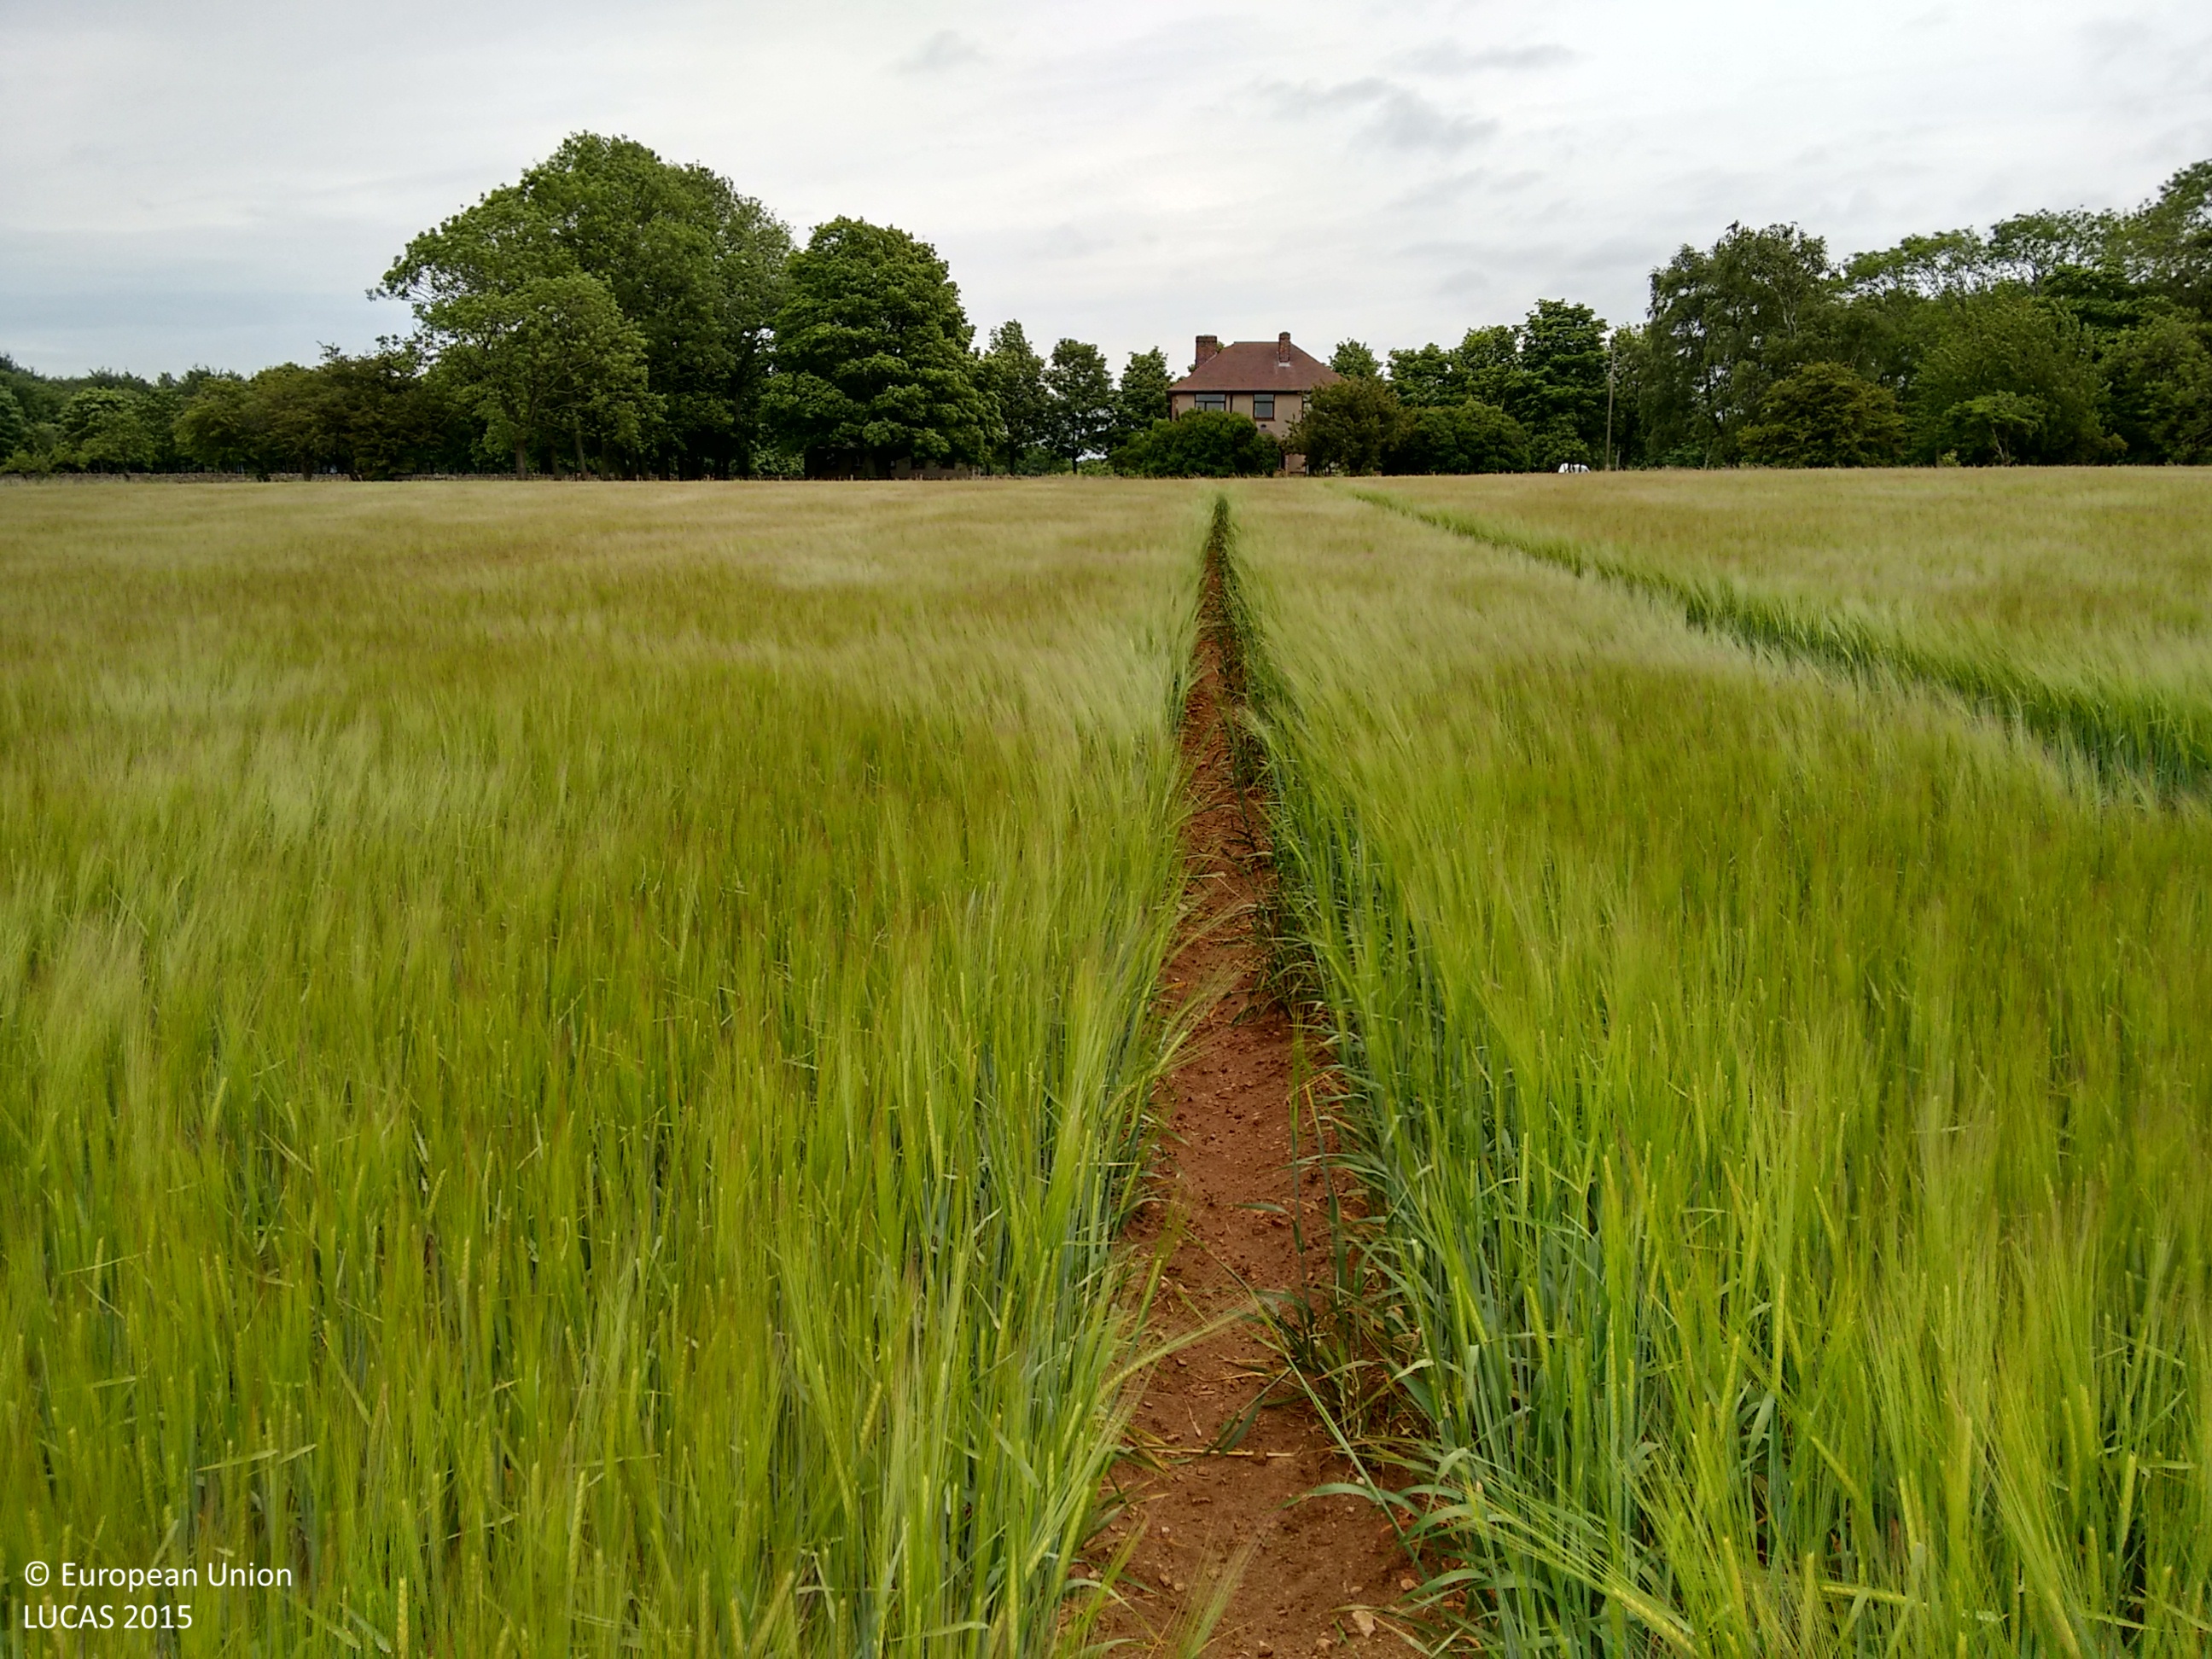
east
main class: Cropland
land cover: Barley
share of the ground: > 75 %
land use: Agriculture (excluding fallow land and kitchen gardens)
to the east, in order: Barley; Grass margins; Artificial constructions in urban areas; Grass margins; Broadleaved woodland; Grass margins; Fences; Grassland without tree/shrub cover
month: June
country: GB
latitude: 53.0330
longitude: -0.5211
